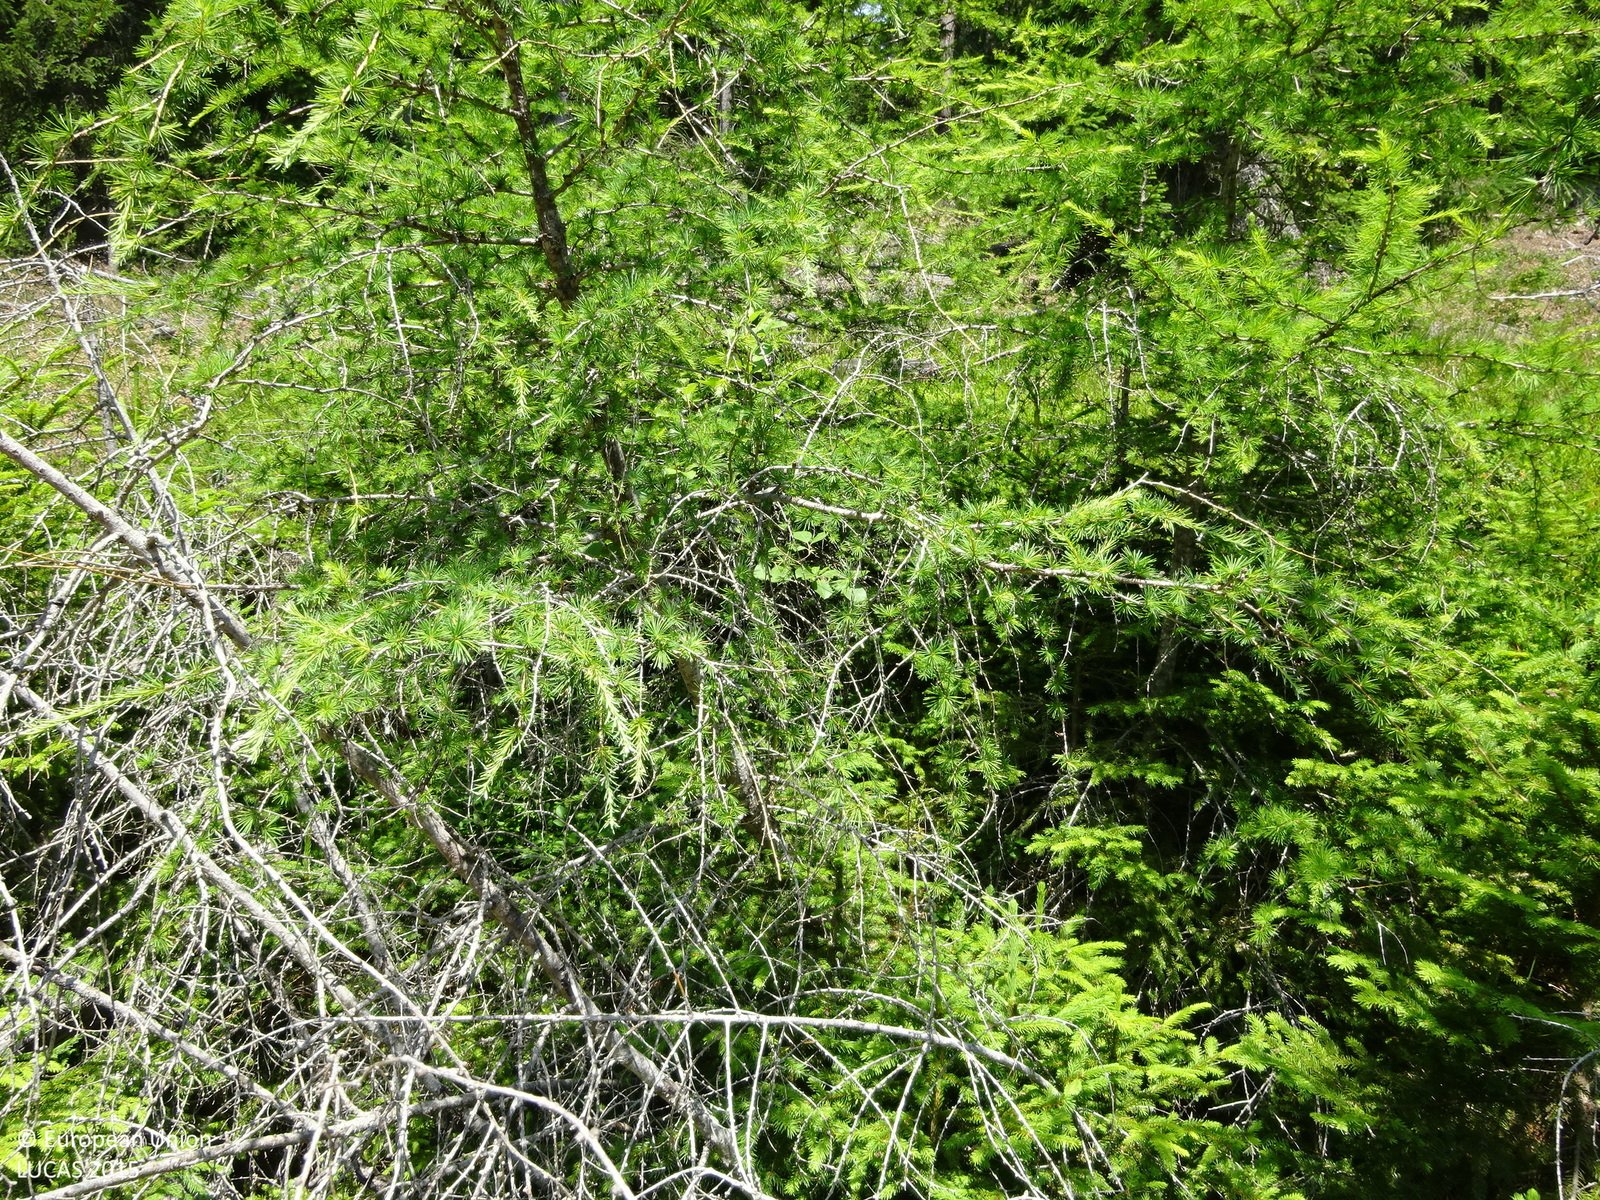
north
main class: Woodland
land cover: Other coniferous woodland
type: alpine coniferous forest
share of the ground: > 75 %
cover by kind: coniferous forest trees 75 %, herbaceous plants 25 %
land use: Forestry
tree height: > 5 m
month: July
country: AT
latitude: 47.0659
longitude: 14.9631
